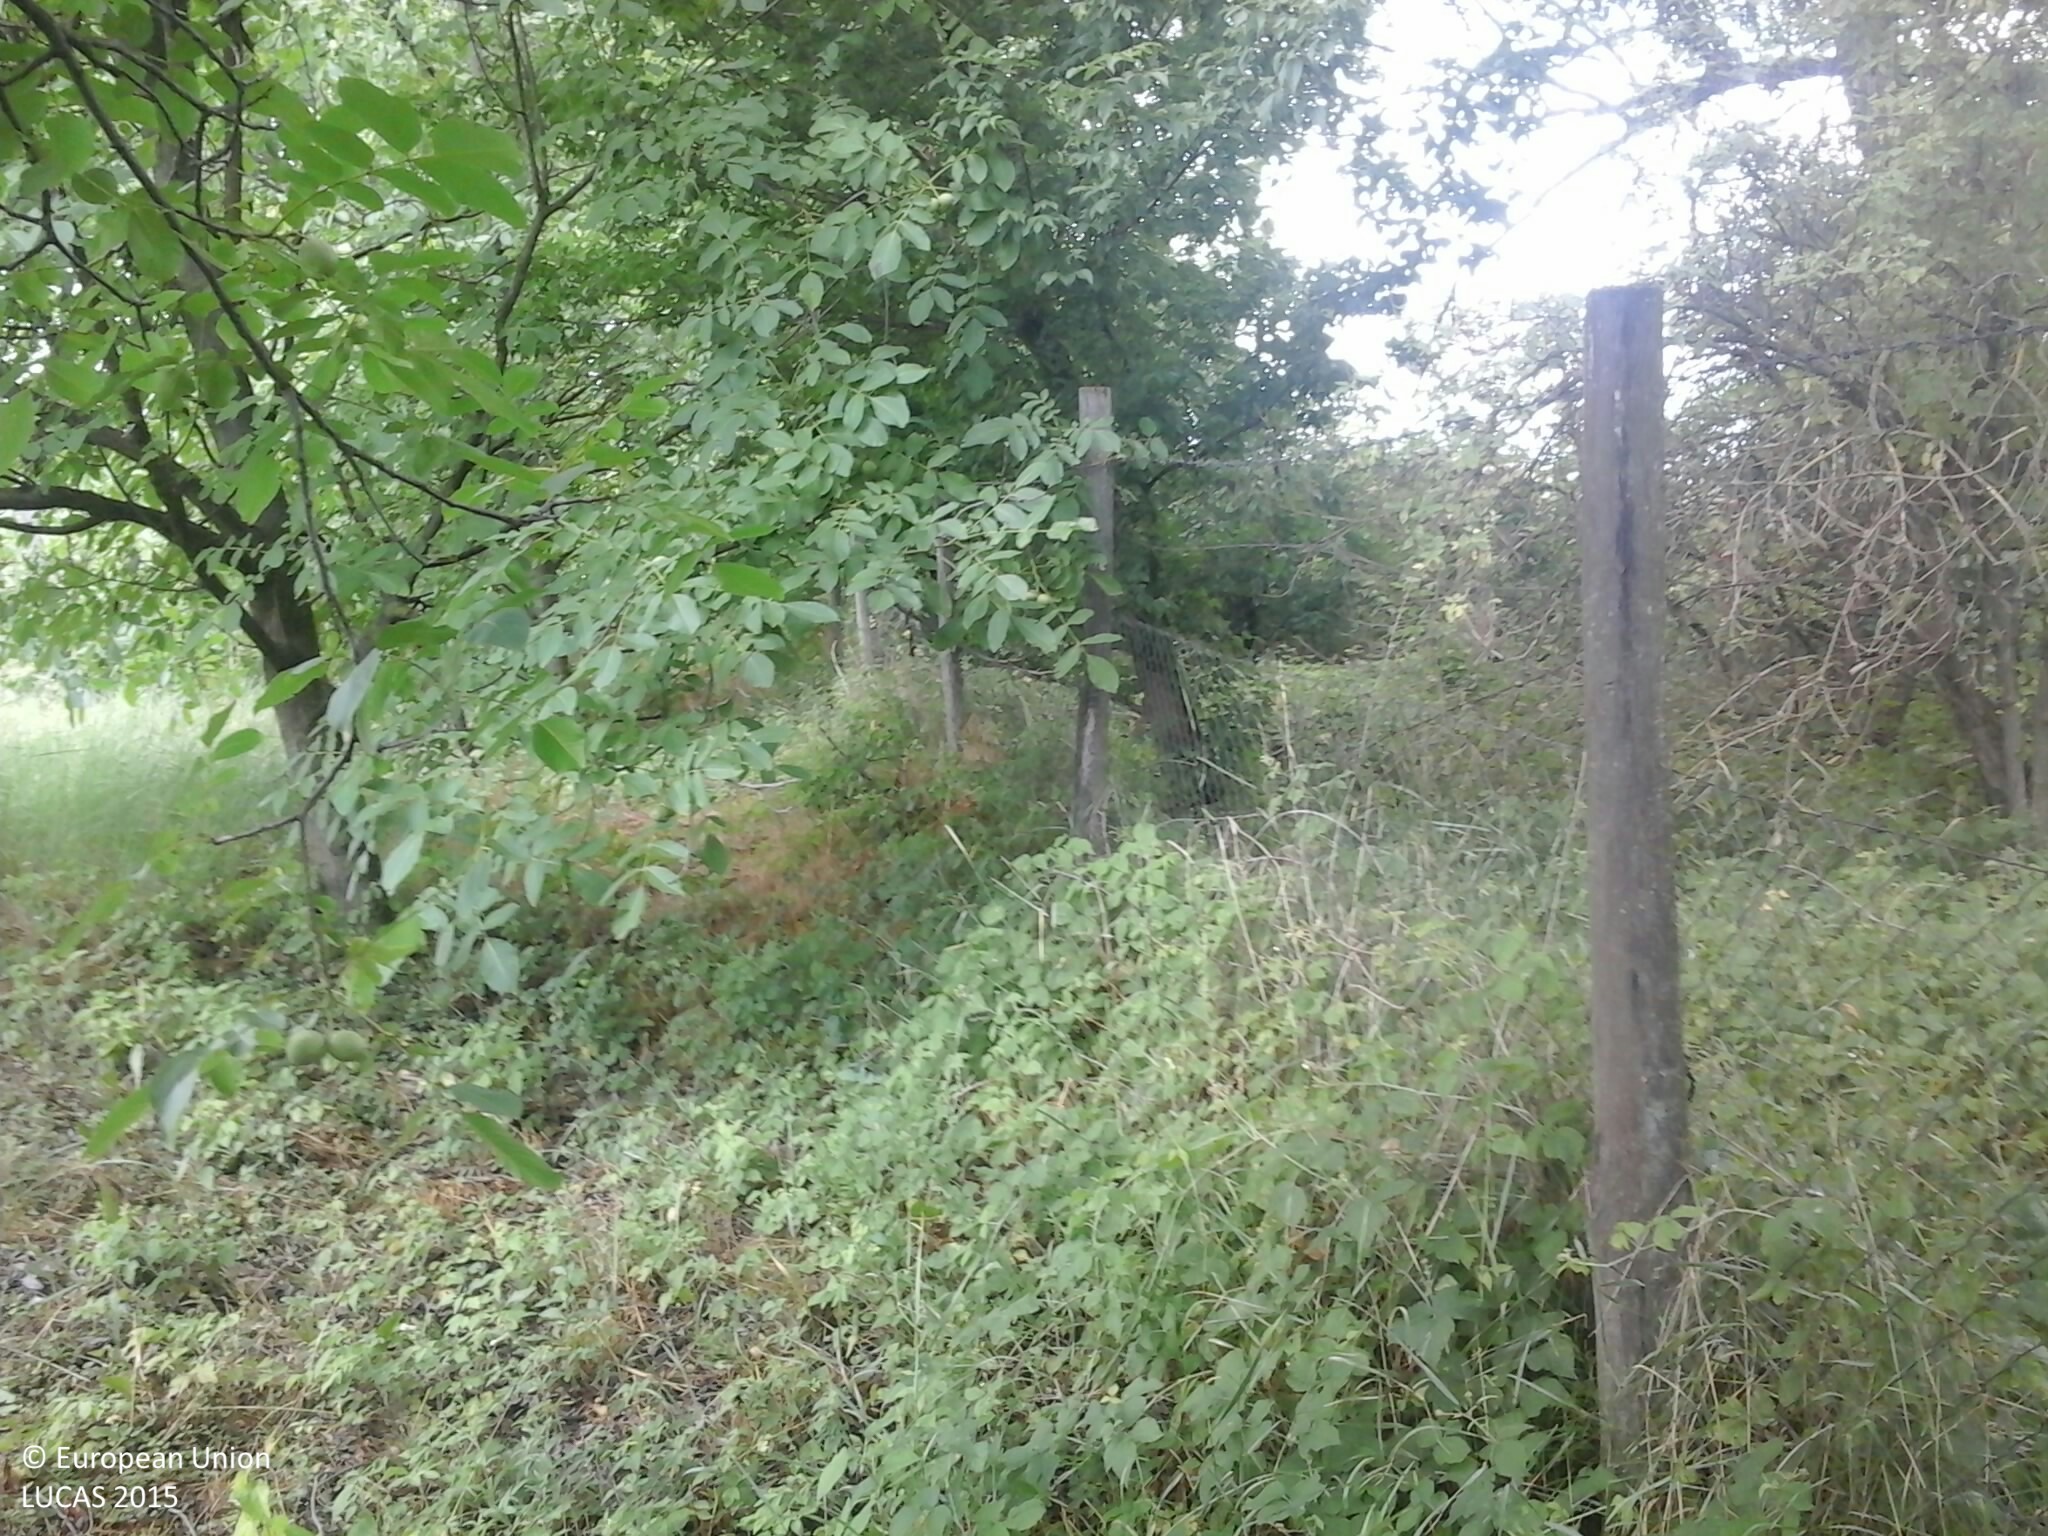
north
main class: Woodland
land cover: Broadleaved woodland
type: exotic forest
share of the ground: > 75 %
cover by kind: broadleaved forest trees 80 %, shrubs 10 %, herbaceous plants 10 %
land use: Abandoned areas
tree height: > 5 m
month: July
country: HU
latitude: 47.9022
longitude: 22.2419
